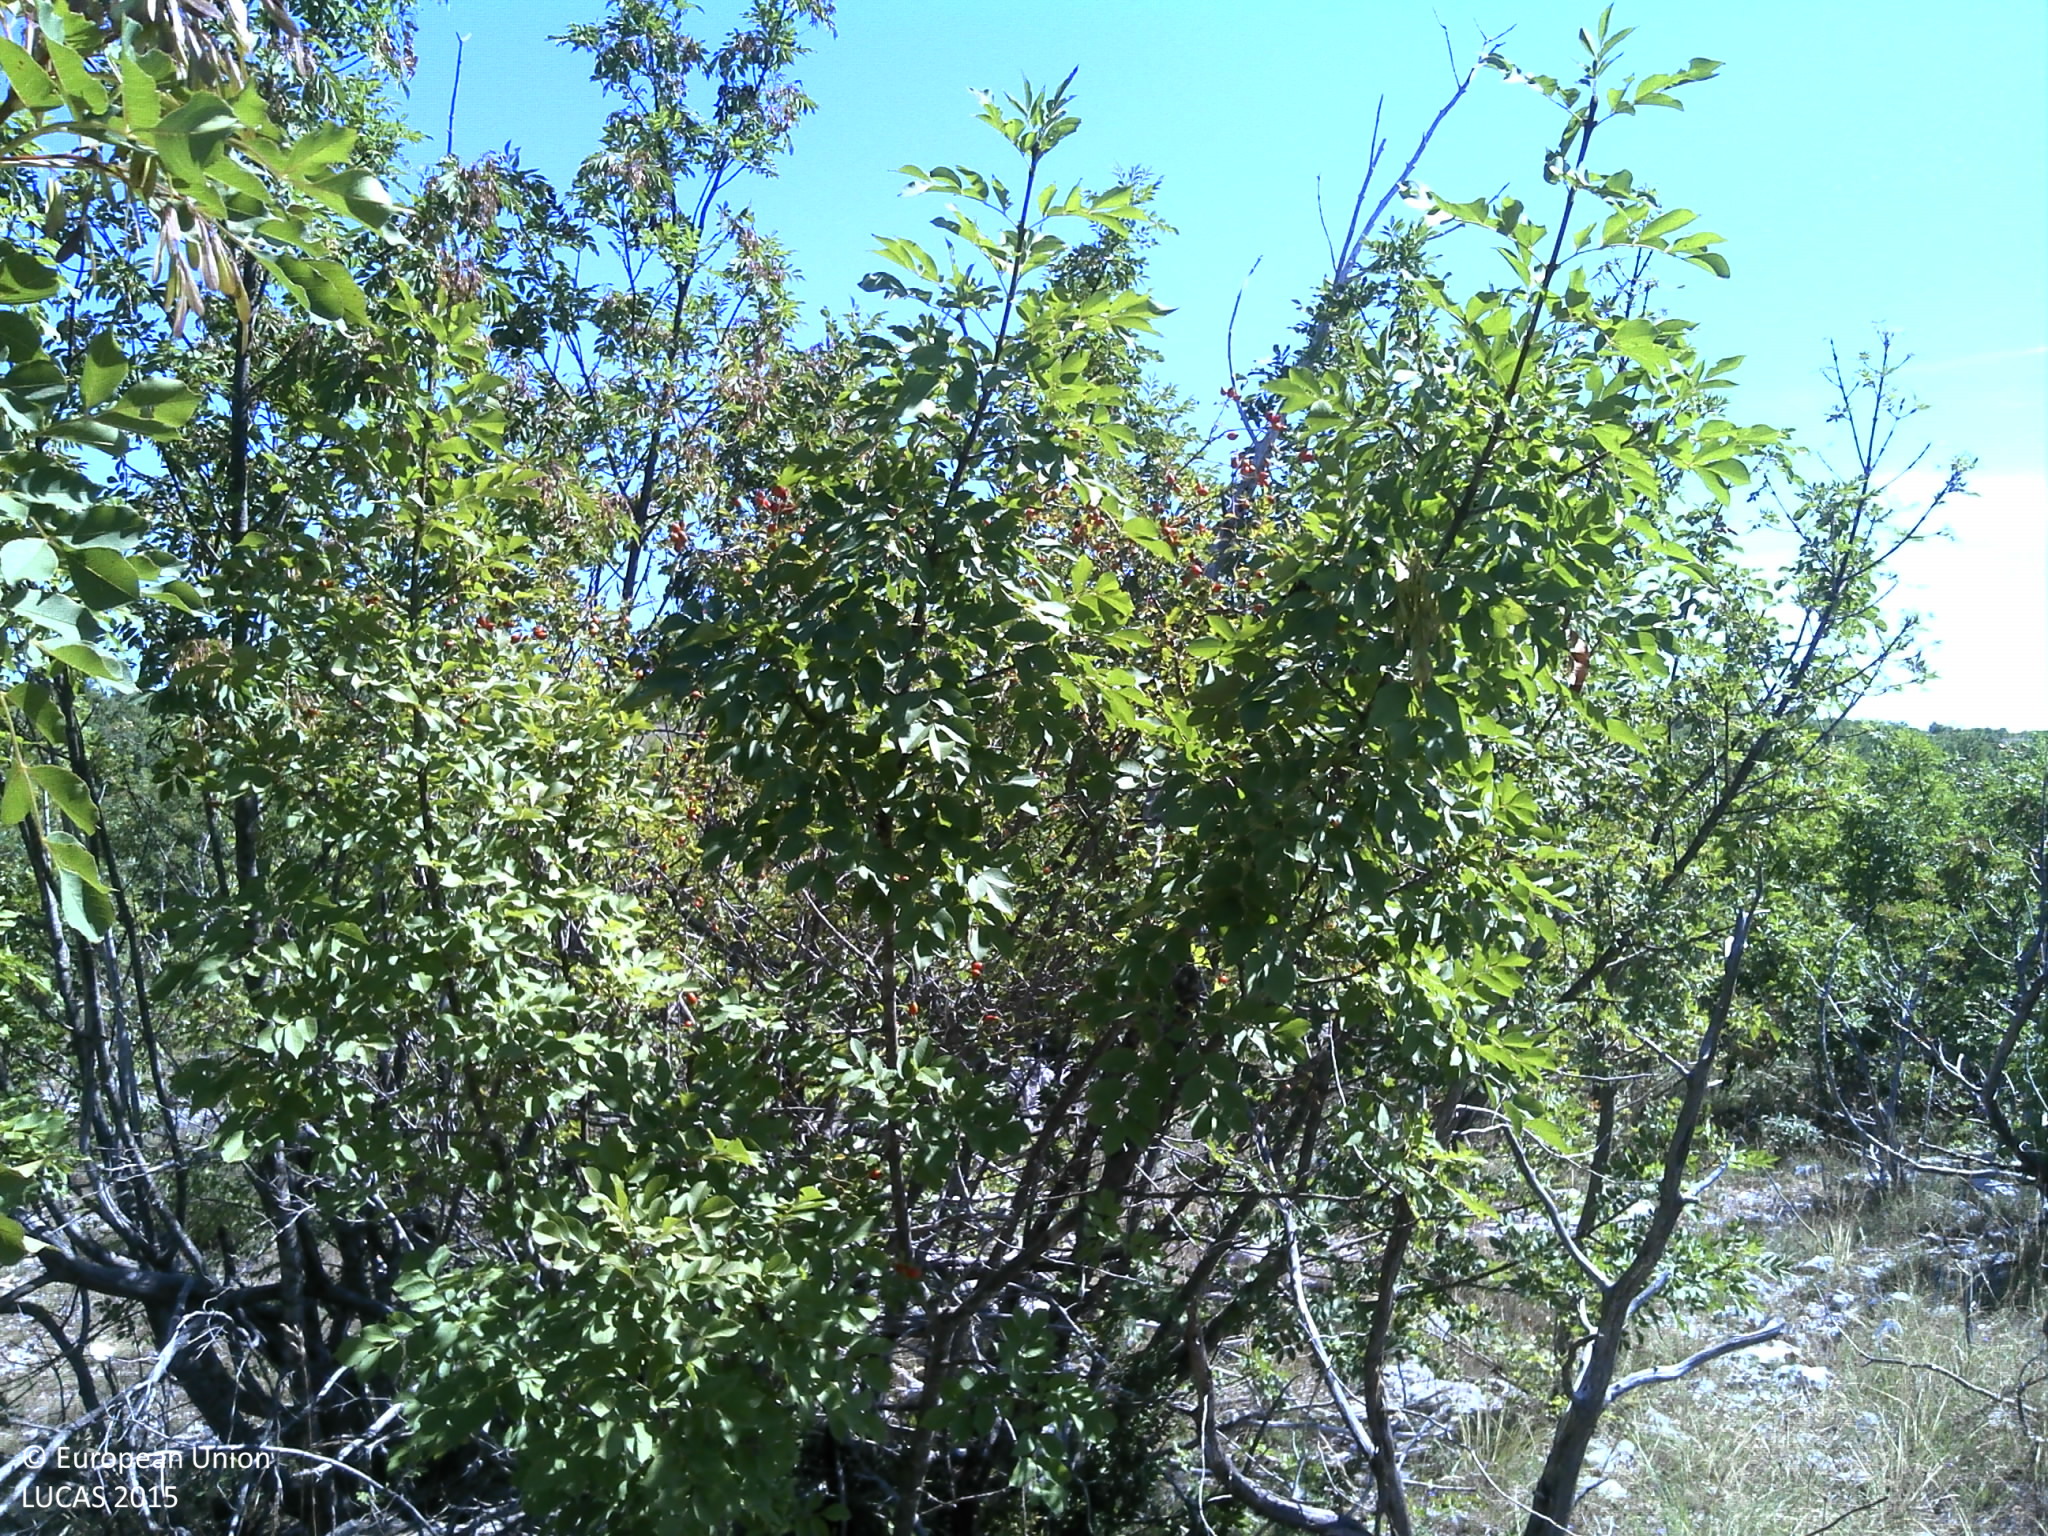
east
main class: Shrubland
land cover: Shrubland with sparse tree cover
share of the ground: 25 - 50 %
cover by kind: herbaceous plants 40 %, shrubs 35 %, consolidated bare surface 10 %, unconsolidated bare surface 10 %, broadleaved forest trees 5 %
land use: Semi-natural and natural areas not in use
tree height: < 5 m
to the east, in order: Shrubland with sparse tree cover; Dry stone walls; Shrubland with sparse tree cover; Dry stone walls; Broadleaved woodland; Grassland with sparse tree/shrub cover; Broadleaved woodland; Shrubland with sparse tree cover; Broadleaved woodland; Grassland with sparse tree/shrub cover
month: September
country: HR
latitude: 43.5820
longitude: 16.2697
